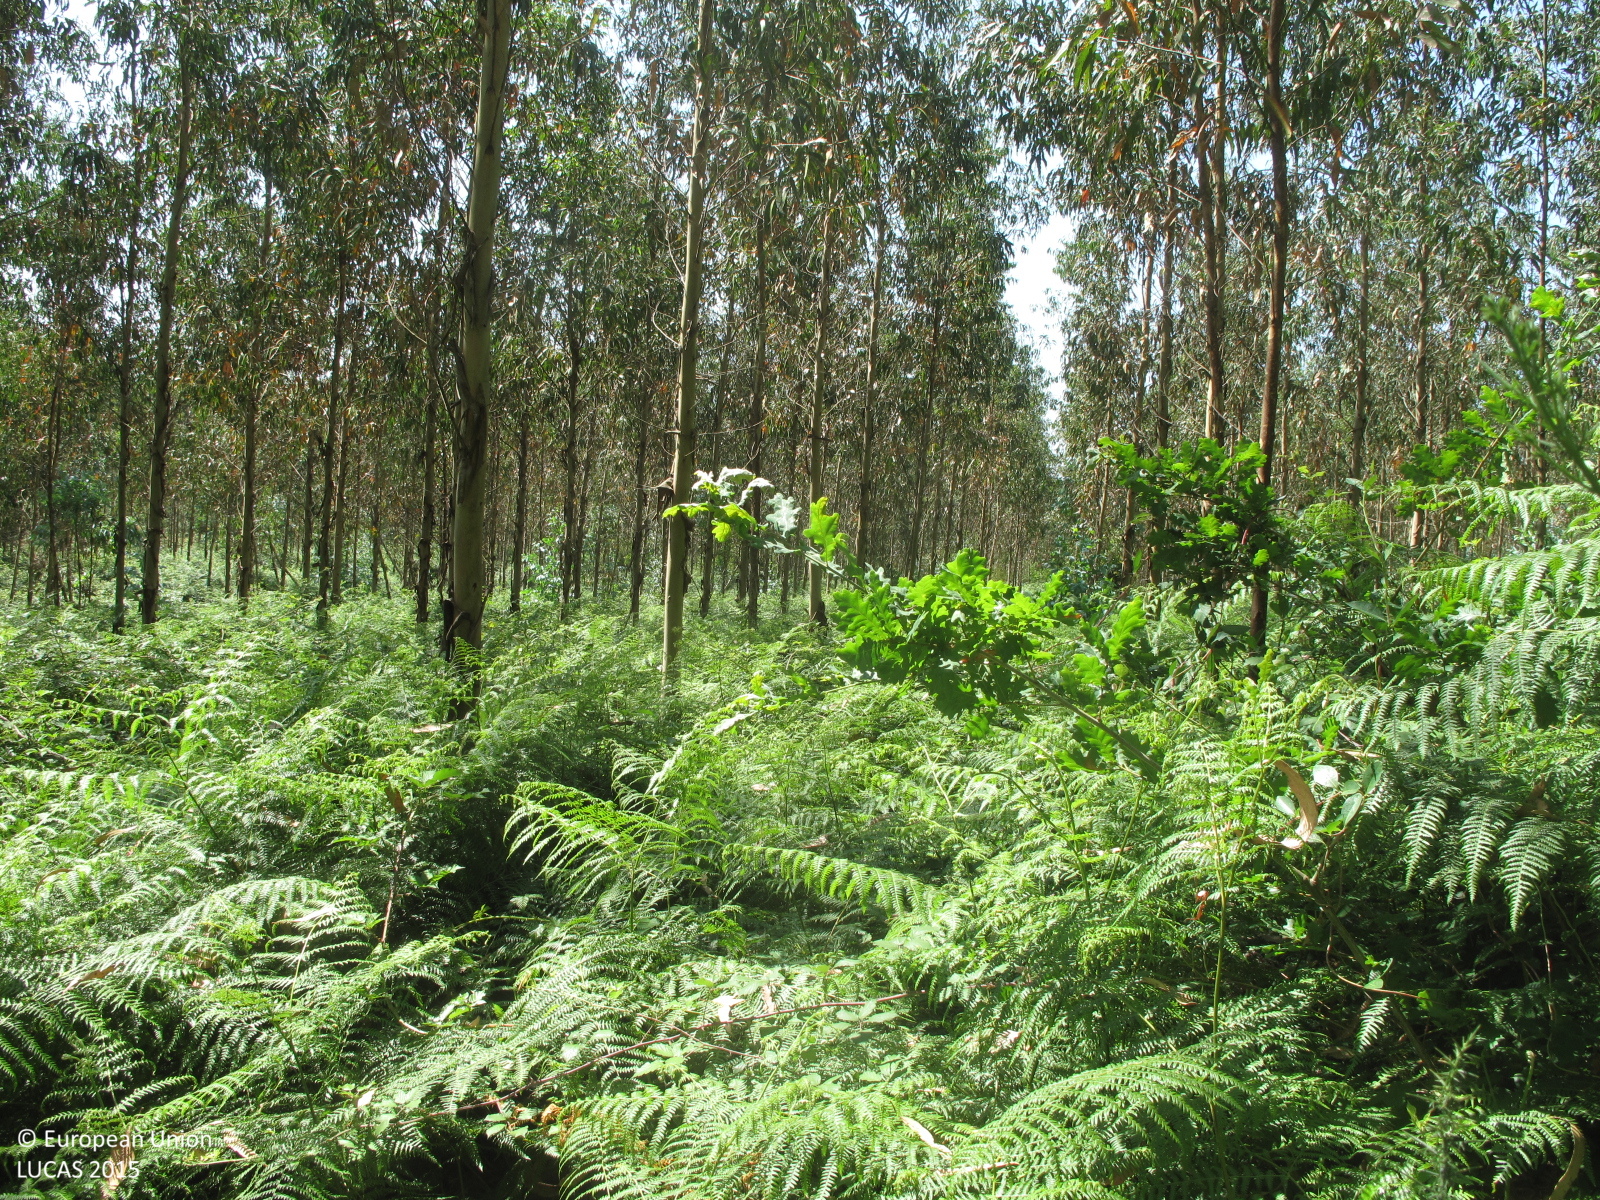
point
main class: Woodland
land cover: Broadleaved woodland
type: exotic forest
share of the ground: 50 - 75 %
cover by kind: broadleaved forest trees 50 %, herbaceous plants 30 %, shrubs 20 %
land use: Forestry
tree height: > 5 m
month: July
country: ES
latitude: 43.2865
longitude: -8.2546
